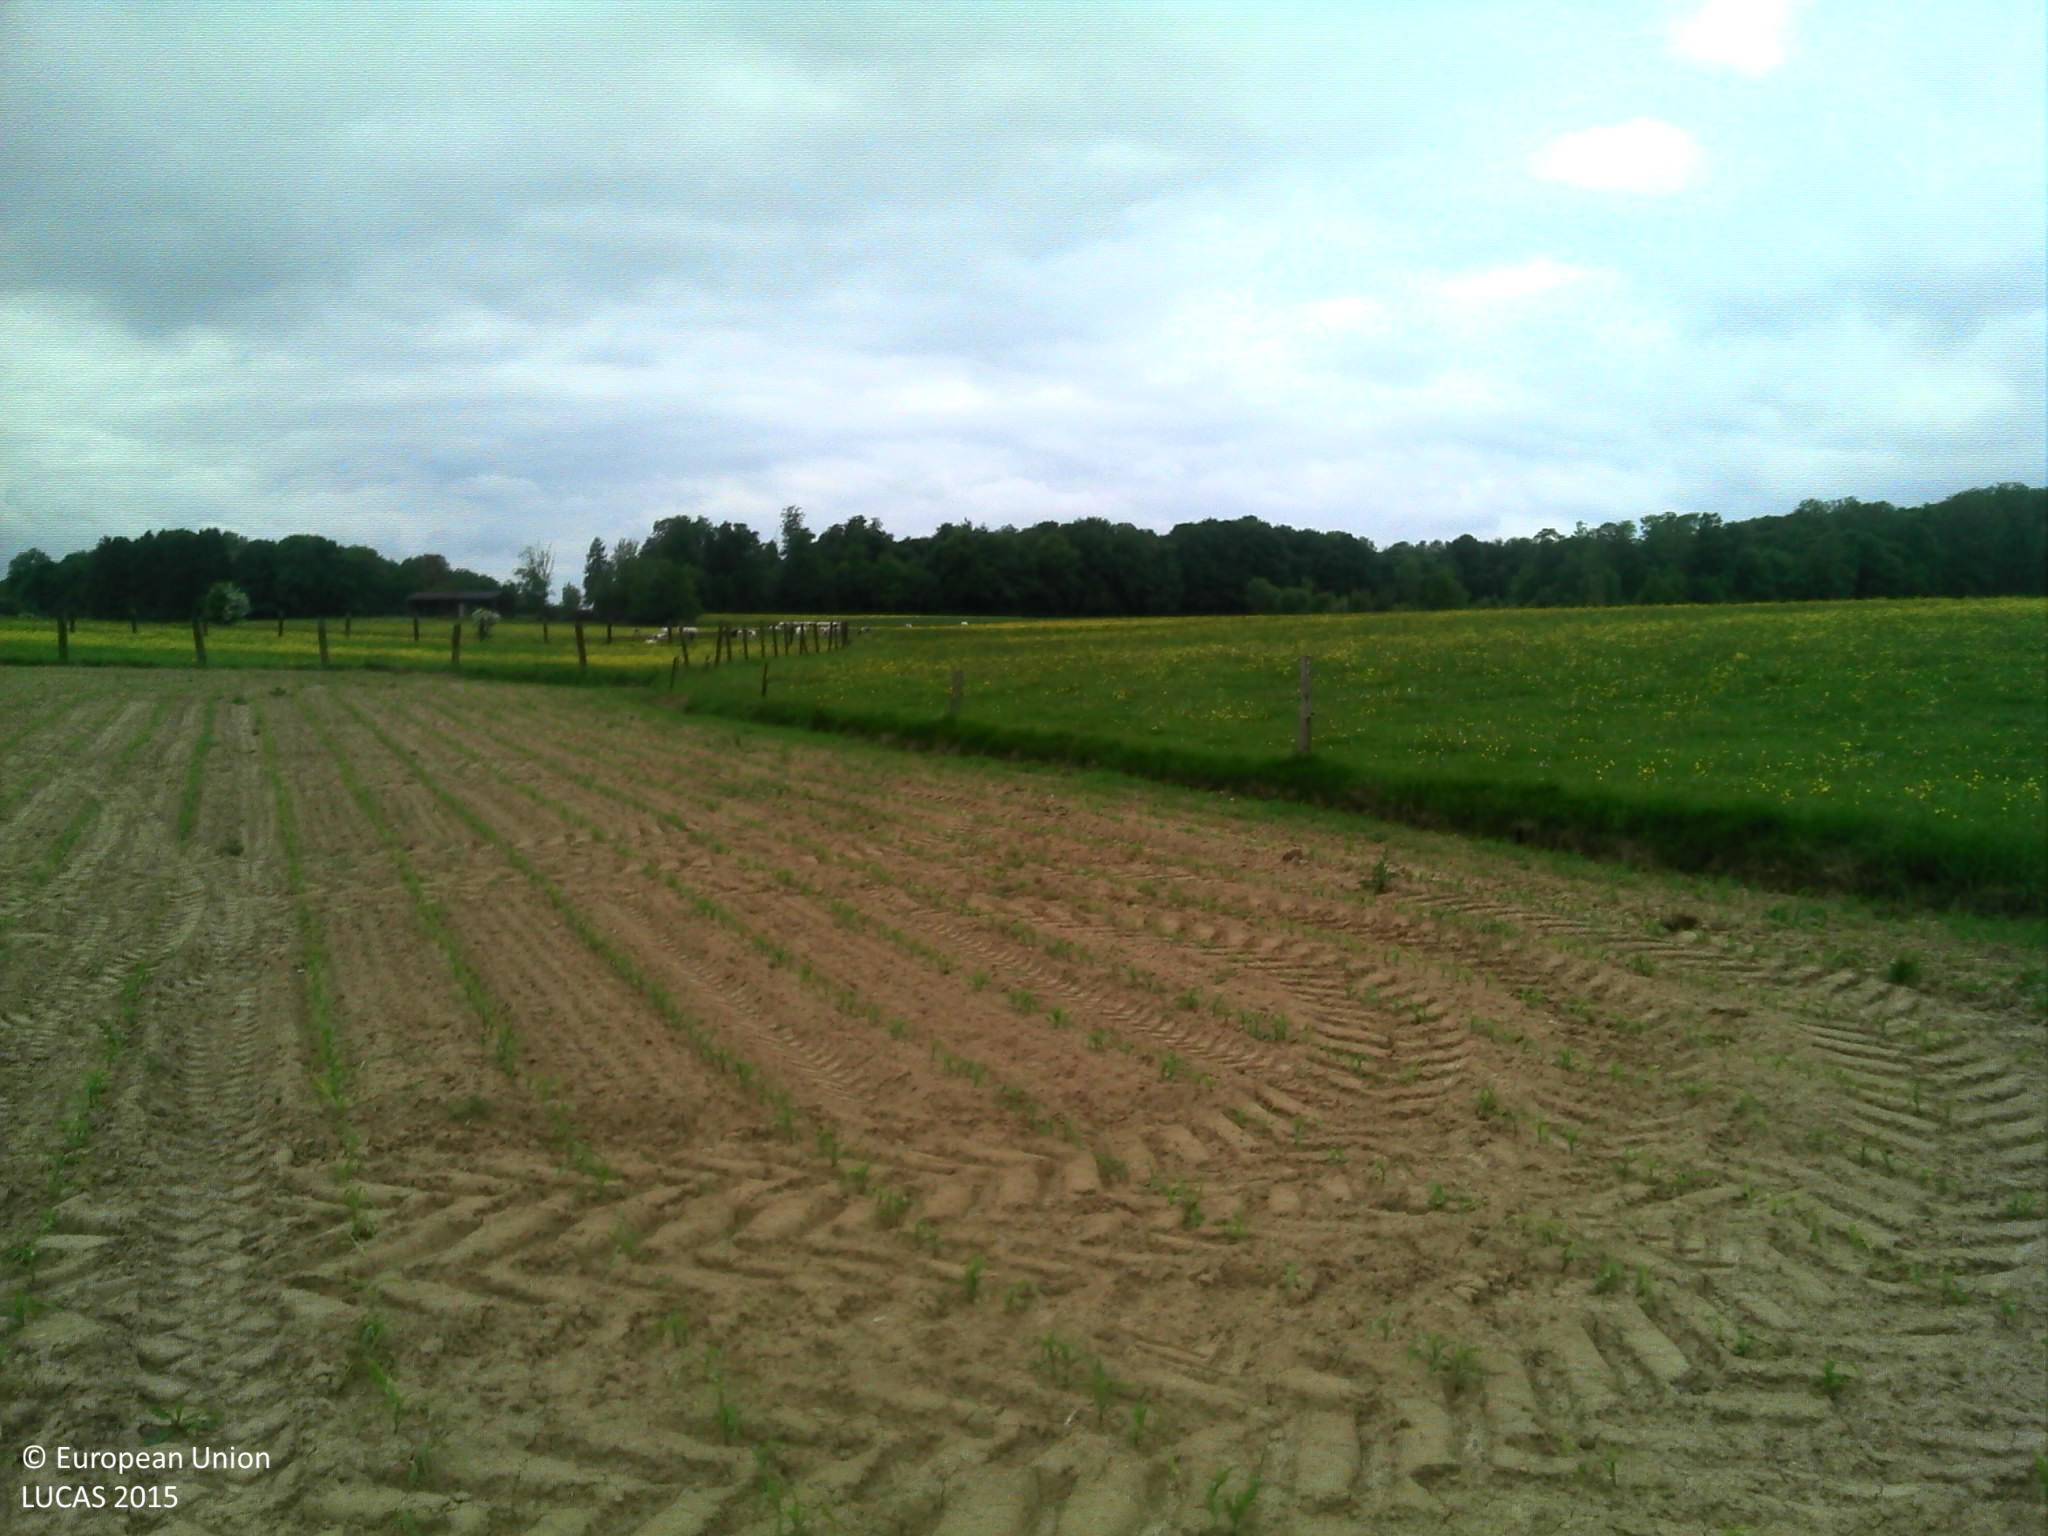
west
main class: Cropland
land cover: Maize
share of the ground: < 10 %
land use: Agriculture (excluding fallow land and kitchen gardens)
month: May
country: BE
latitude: 50.3548
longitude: 5.2330
